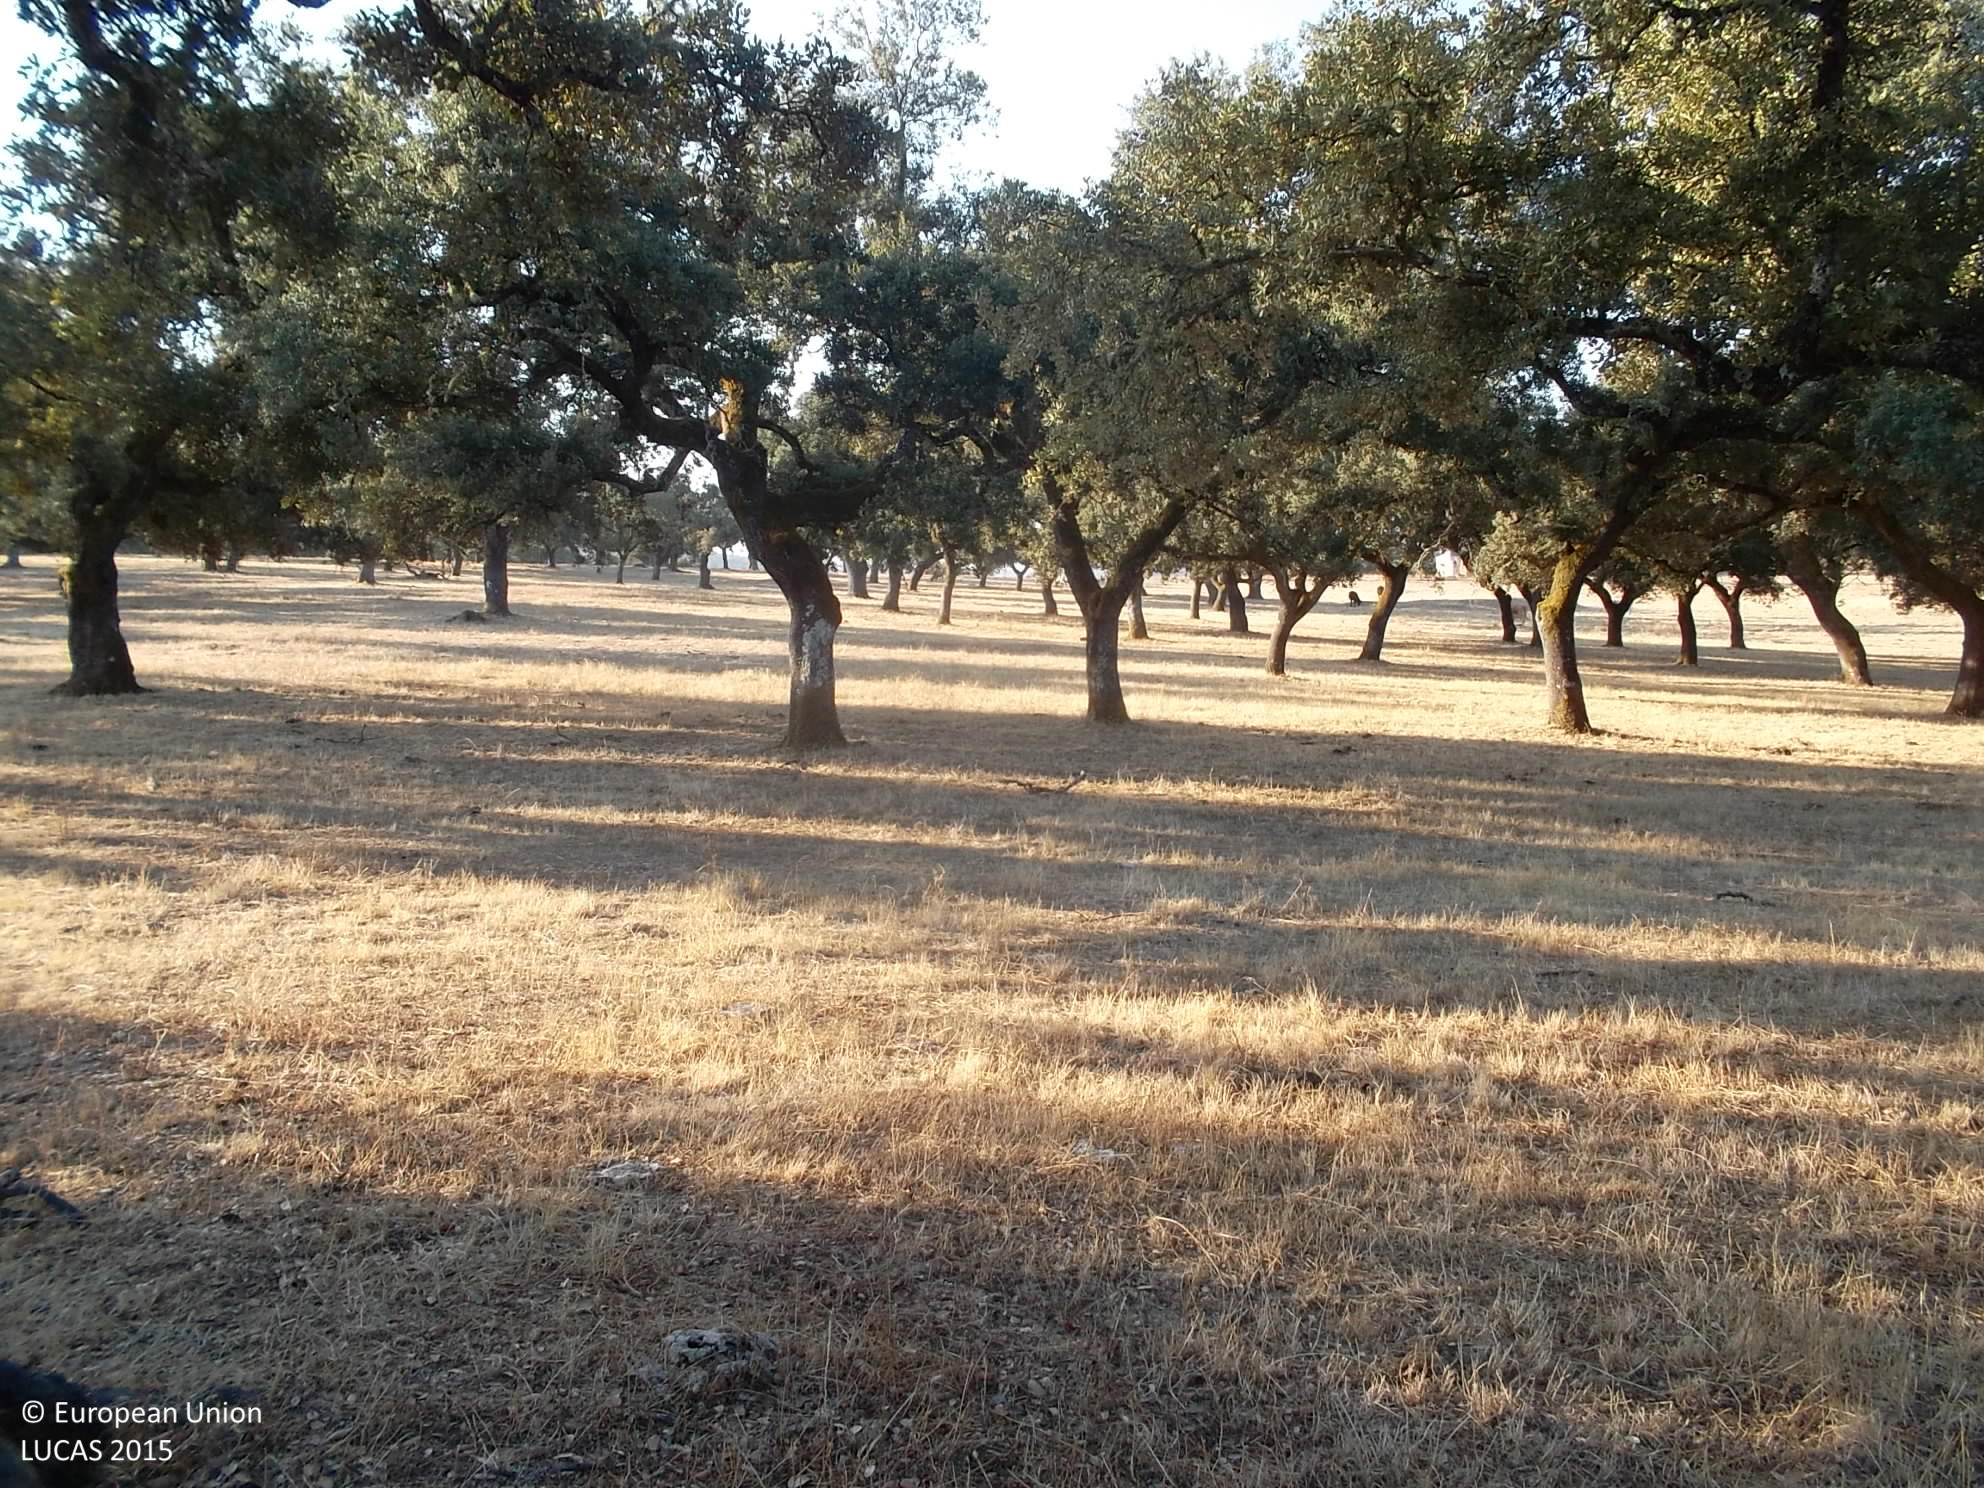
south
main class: Woodland
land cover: Broadleaved woodland
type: broadleaved evergreen forest
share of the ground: 10 - 25 %
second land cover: Grassland without tree/shrub cover
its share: > 75 %
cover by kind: herbaceous plants 85 %, broadleaved forest trees 15 %
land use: Forestry
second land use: Agriculture (excluding fallow land and kitchen gardens)
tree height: > 5 m
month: September
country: ES
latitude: 38.1093
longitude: -6.5733
